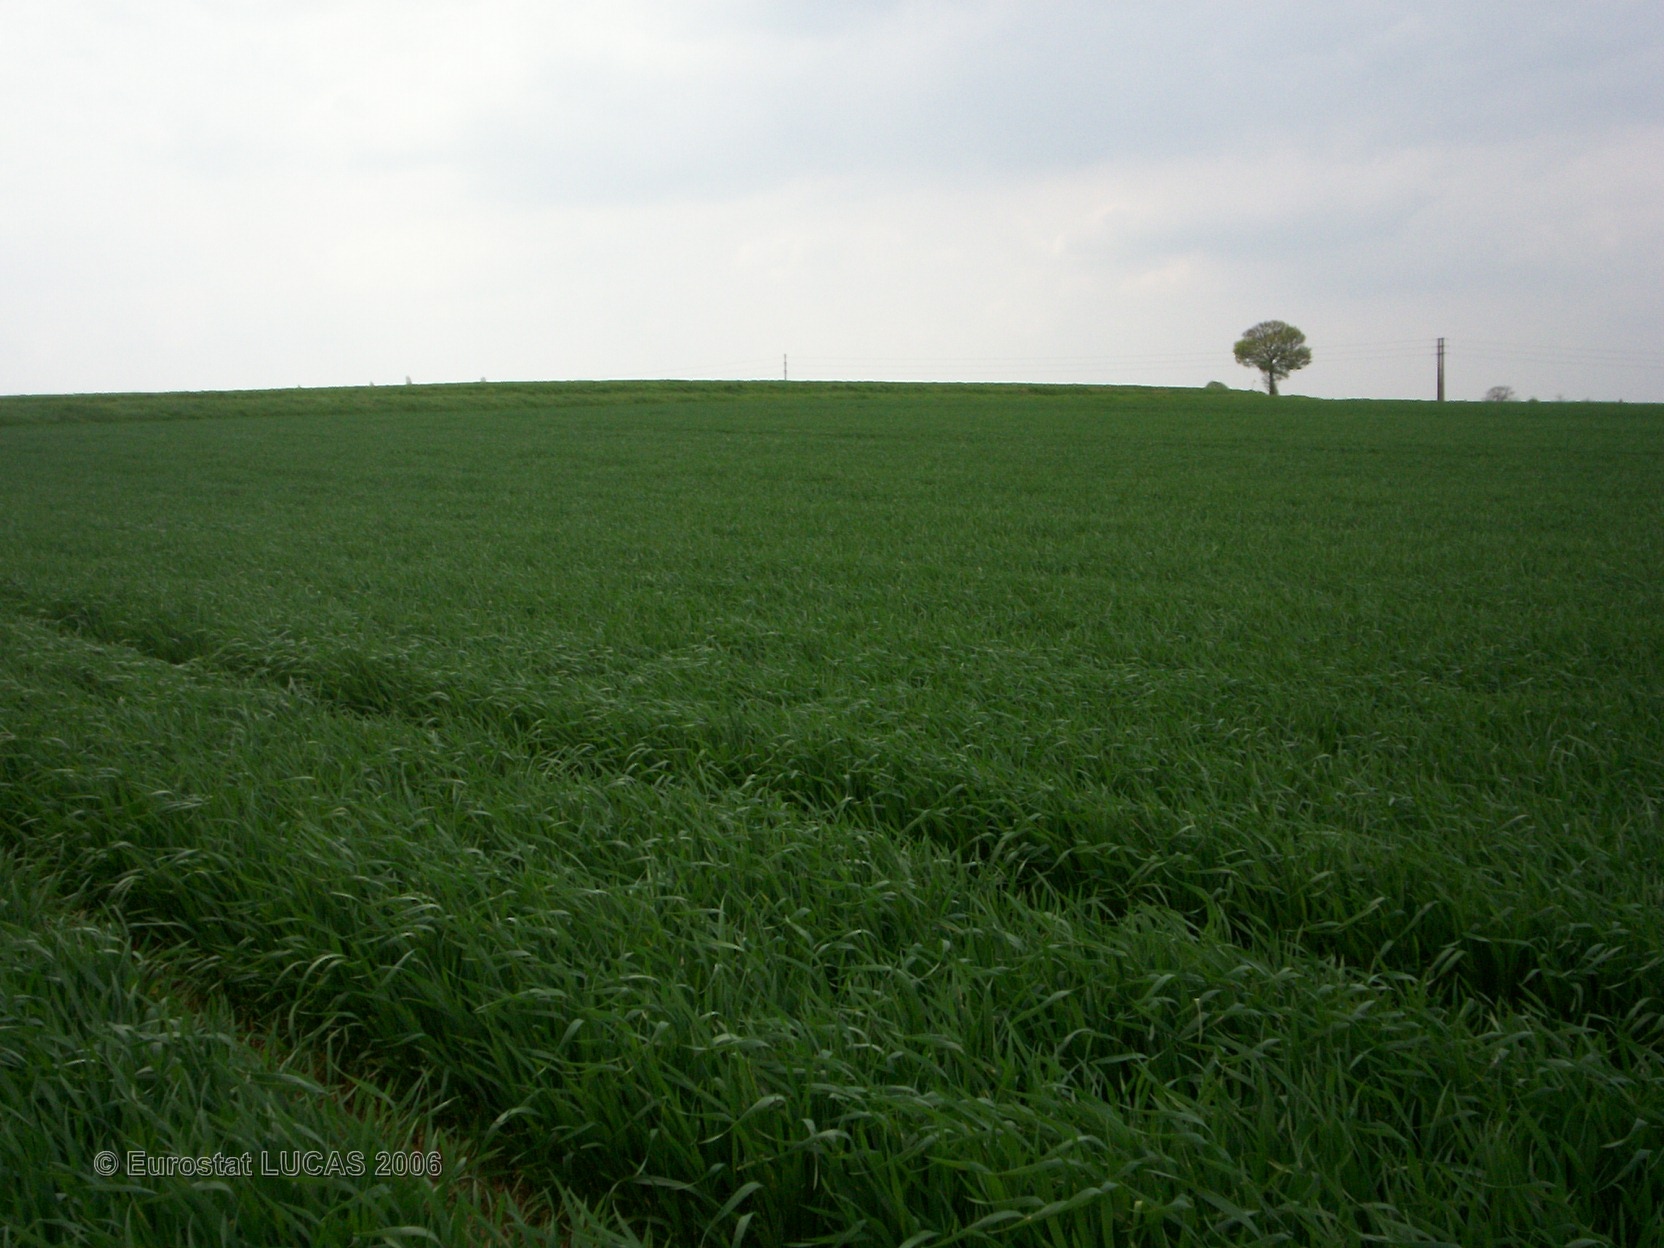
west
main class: Cropland
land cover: Common wheat
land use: Agriculture (excluding fallow land and kitchen gardens)
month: April
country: FR
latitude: 47.1727
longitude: 3.0423
